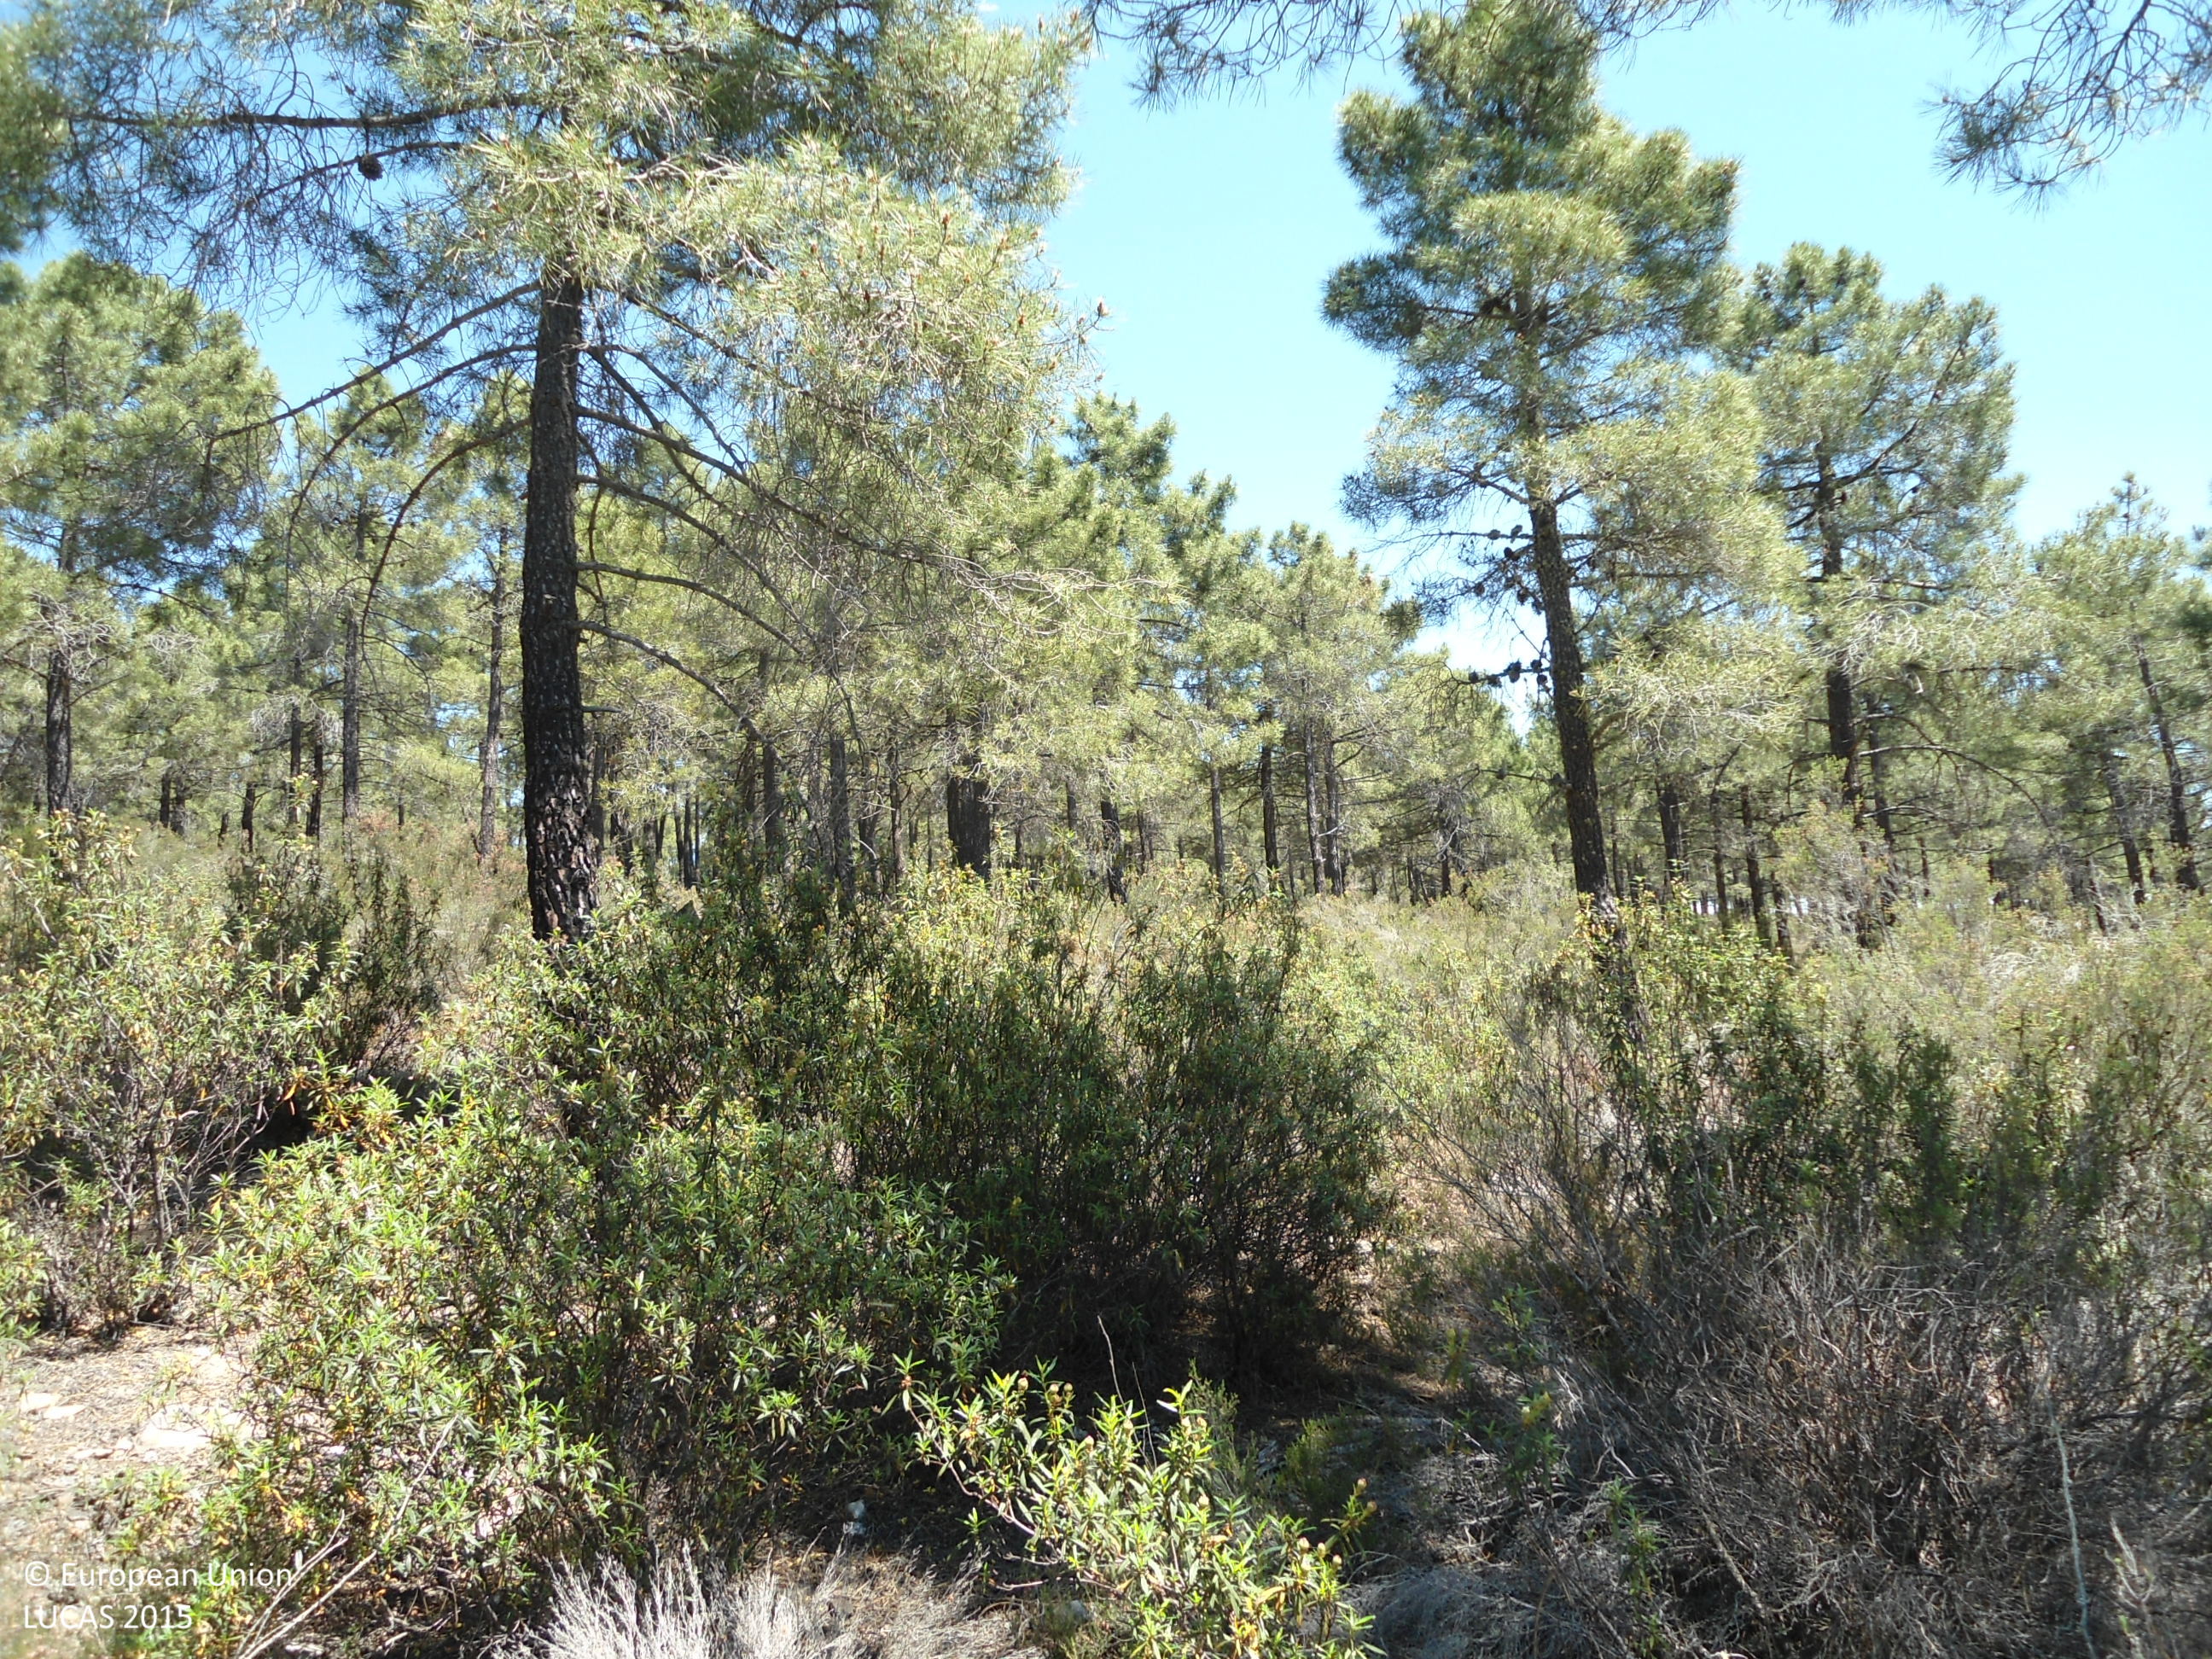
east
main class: Woodland
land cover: Pine dominated coniferous woodland
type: coniferous forest of the mediterranean region
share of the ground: > 75 %
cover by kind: coniferous forest trees 90 %, shrubs 10 %
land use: Forestry
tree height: > 5 m
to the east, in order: Pine dominated coniferous woodland; Rock outcrops; Pine dominated coniferous woodland; Tracks; Pine dominated coniferous woodland; Shrubland with sparse tree cover; Tracks; Shrubland without tree cover
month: June
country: ES
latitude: 42.1170
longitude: -6.0546
